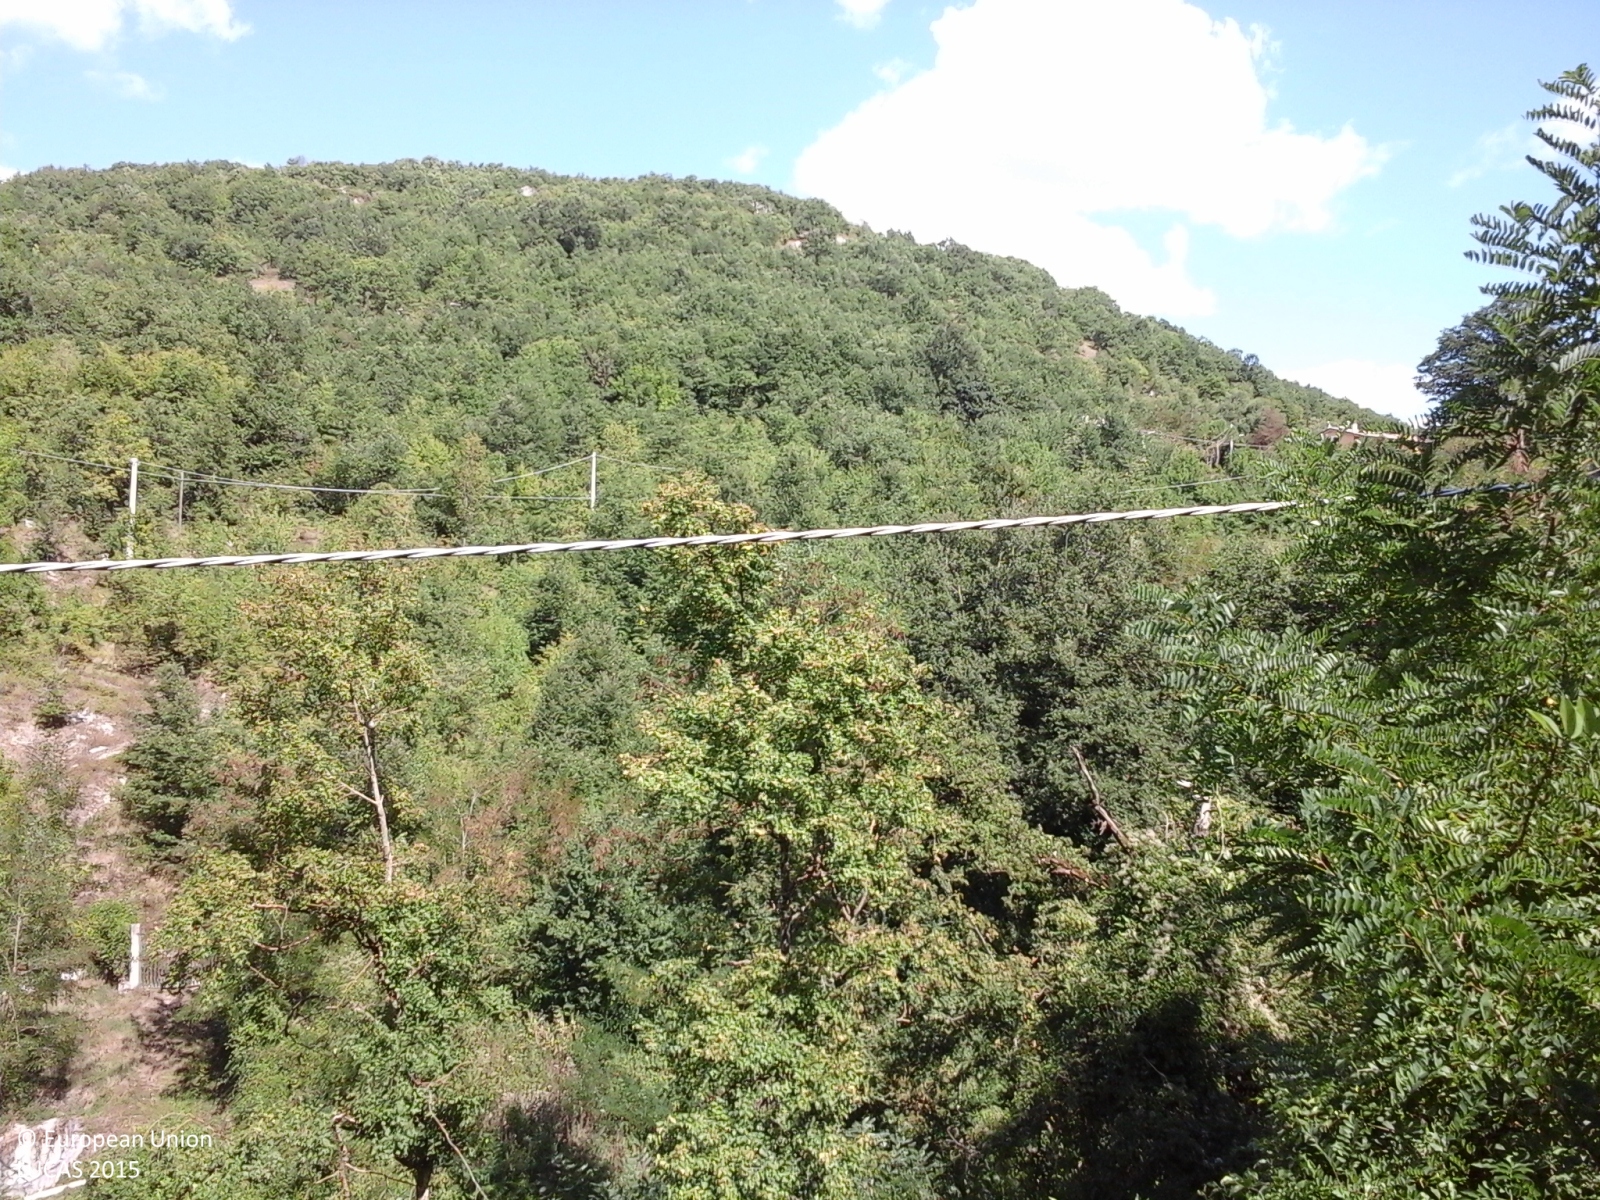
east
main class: Woodland
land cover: Broadleaved woodland
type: thermophilous deciduous forest
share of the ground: > 75 %
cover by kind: broadleaved forest trees 85 %, shrubs 10 %, herbaceous plants 5 %
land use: Semi-natural and natural areas not in use
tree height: > 5 m
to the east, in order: Broadleaved woodland; Paved roads, cycling and walking lanes; Broadleaved woodland; Electric lines; Broadleaved woodland
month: August
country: IT
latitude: 41.5661
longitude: 14.3375
